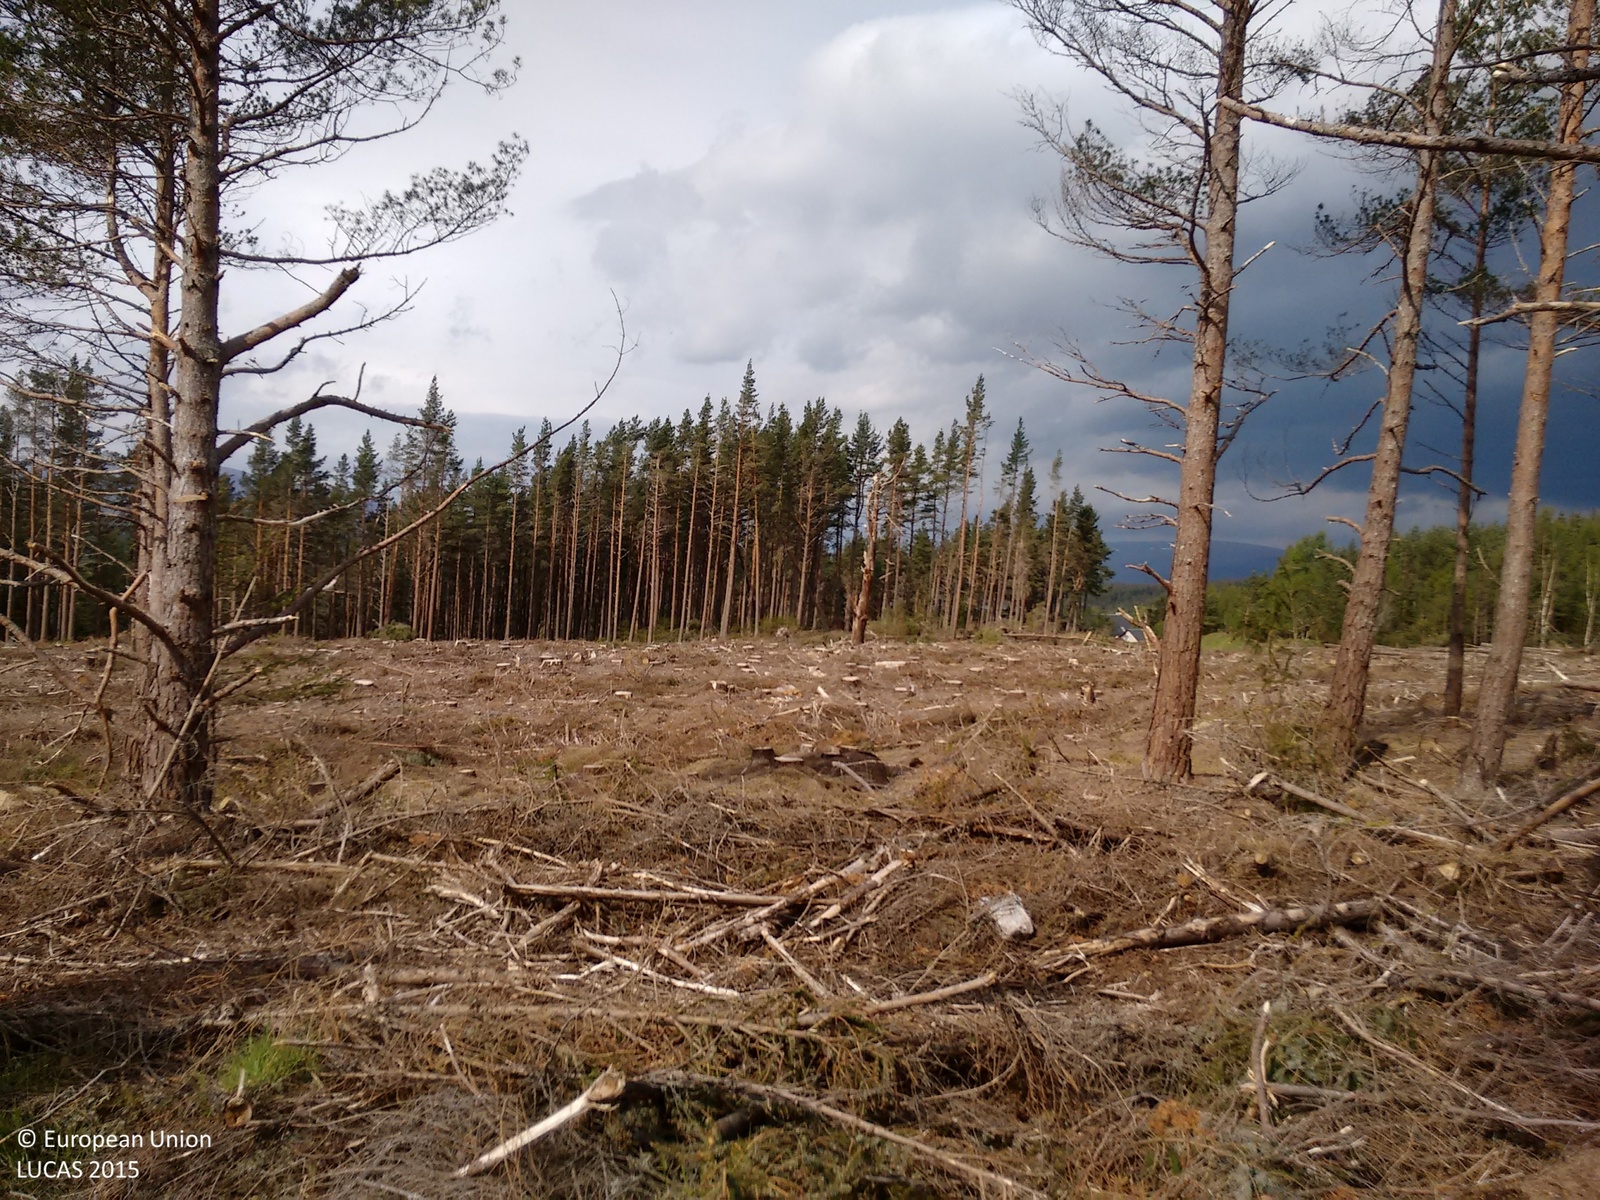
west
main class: Woodland
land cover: Pine dominated coniferous woodland
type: hemiboreal forest and nemoral coniferous forest and mixed broadleaved-coniferous forest
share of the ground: 25 - 50 %
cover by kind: lichens and mosses 50 %, coniferous forest trees 30 %
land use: Forestry
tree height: > 5 m
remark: Clear cut
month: June
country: GB
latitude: 57.1675
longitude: -3.6856
